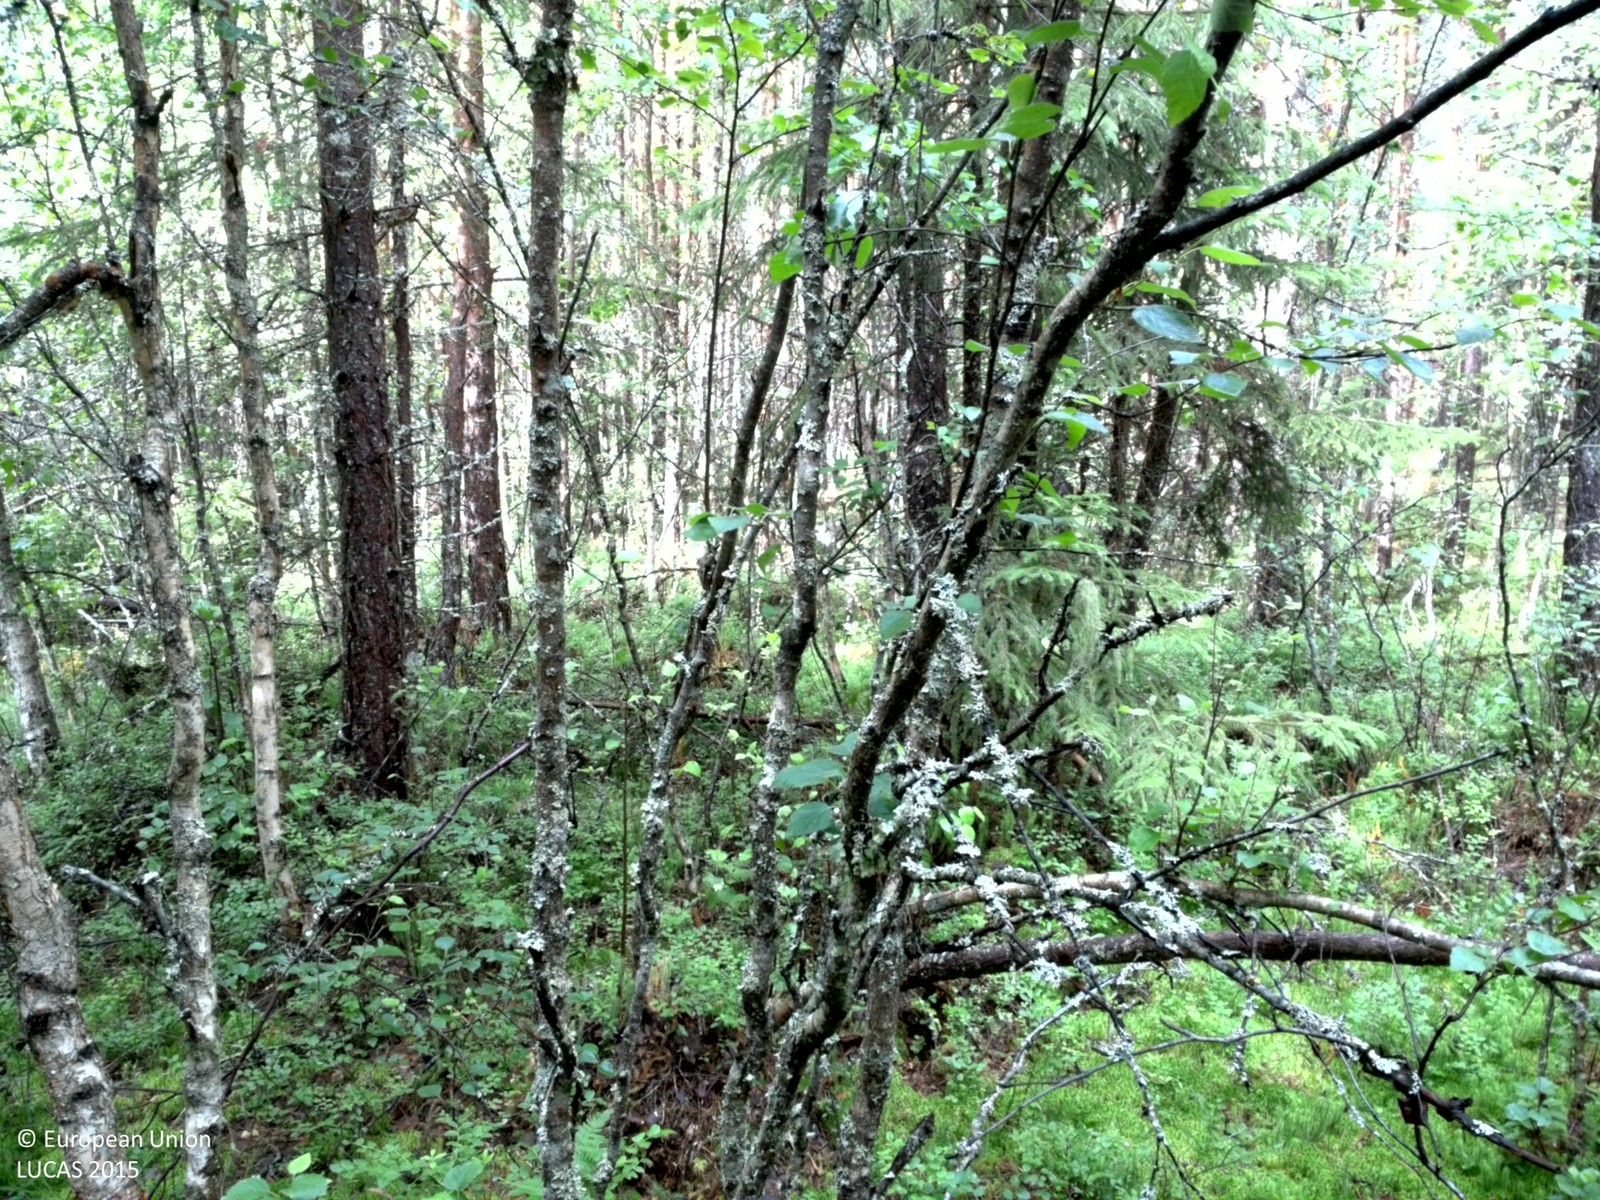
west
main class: Woodland
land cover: Pine dominated mixed woodland
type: boreal forest
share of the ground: > 75 %
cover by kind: coniferous forest trees 55 %, broadleaved forest trees 25 %, lichens and mosses 20 %
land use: Forestry
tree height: > 5 m
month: July
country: SE
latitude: 60.0192
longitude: 17.1143
